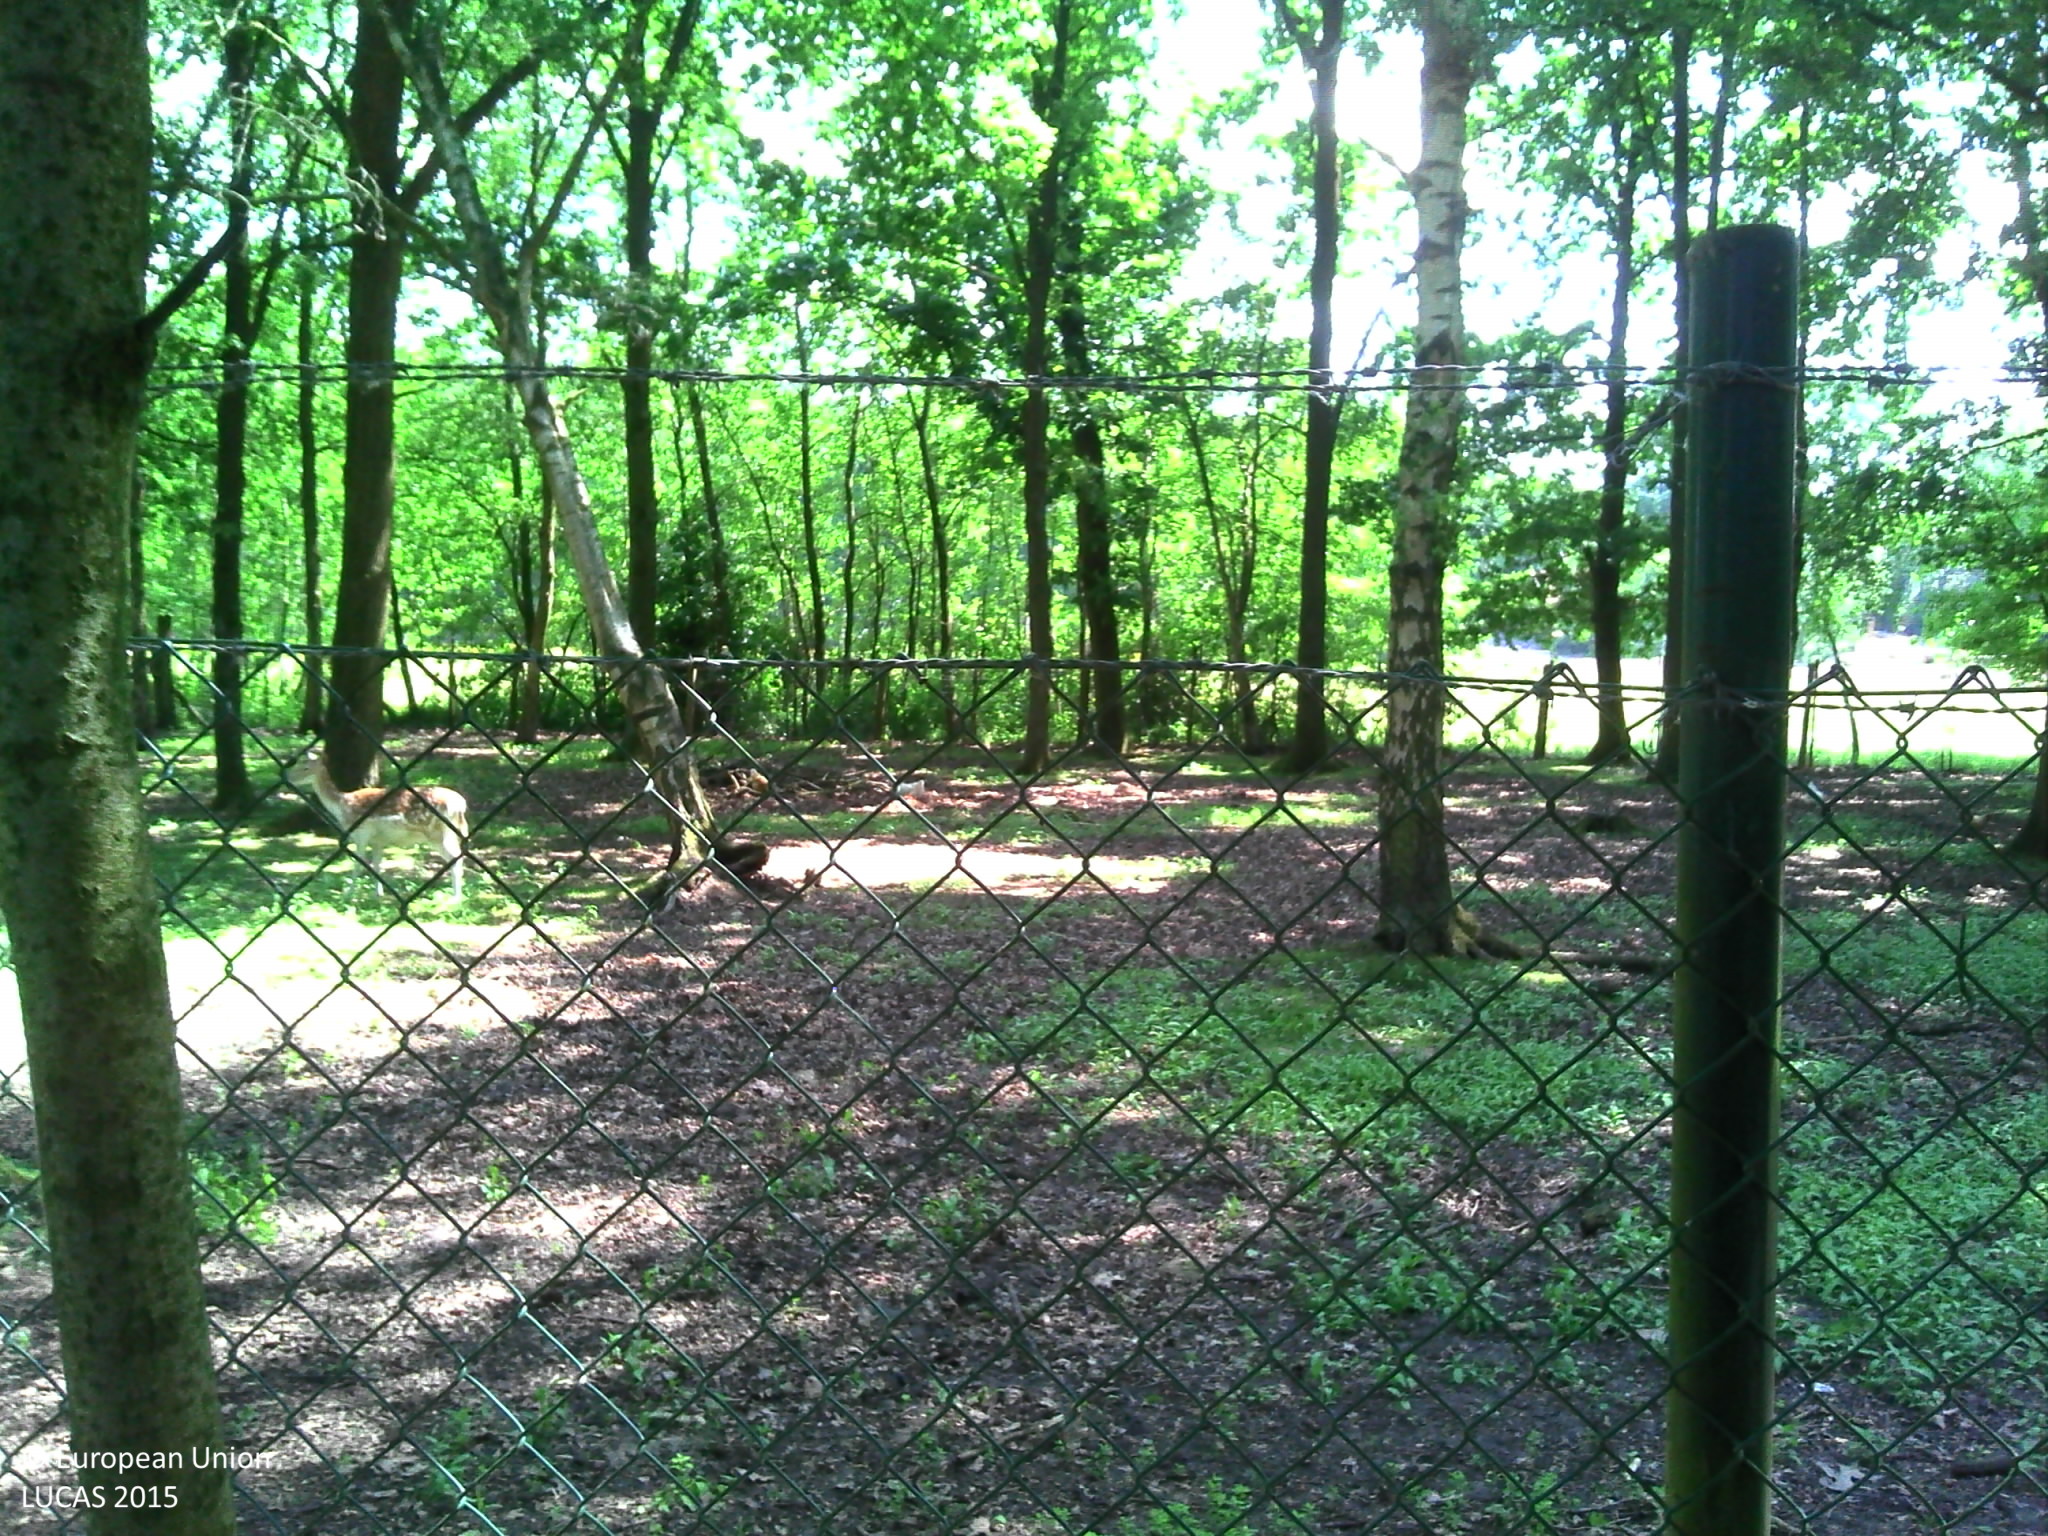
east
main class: Woodland
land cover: Broadleaved woodland
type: mesophytic deciduous forest
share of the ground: > 75 %
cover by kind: broadleaved forest trees 100 %
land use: Forestry
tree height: > 5 m
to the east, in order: Broadleaved woodland; Fences; Managed hedges; Grassland without tree/shrub cover; Fences; Grassland without tree/shrub cover; Fences; Broadleaved woodland; Spruce dominated mixed woodland
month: June
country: BE
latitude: 51.0175
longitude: 3.9927
